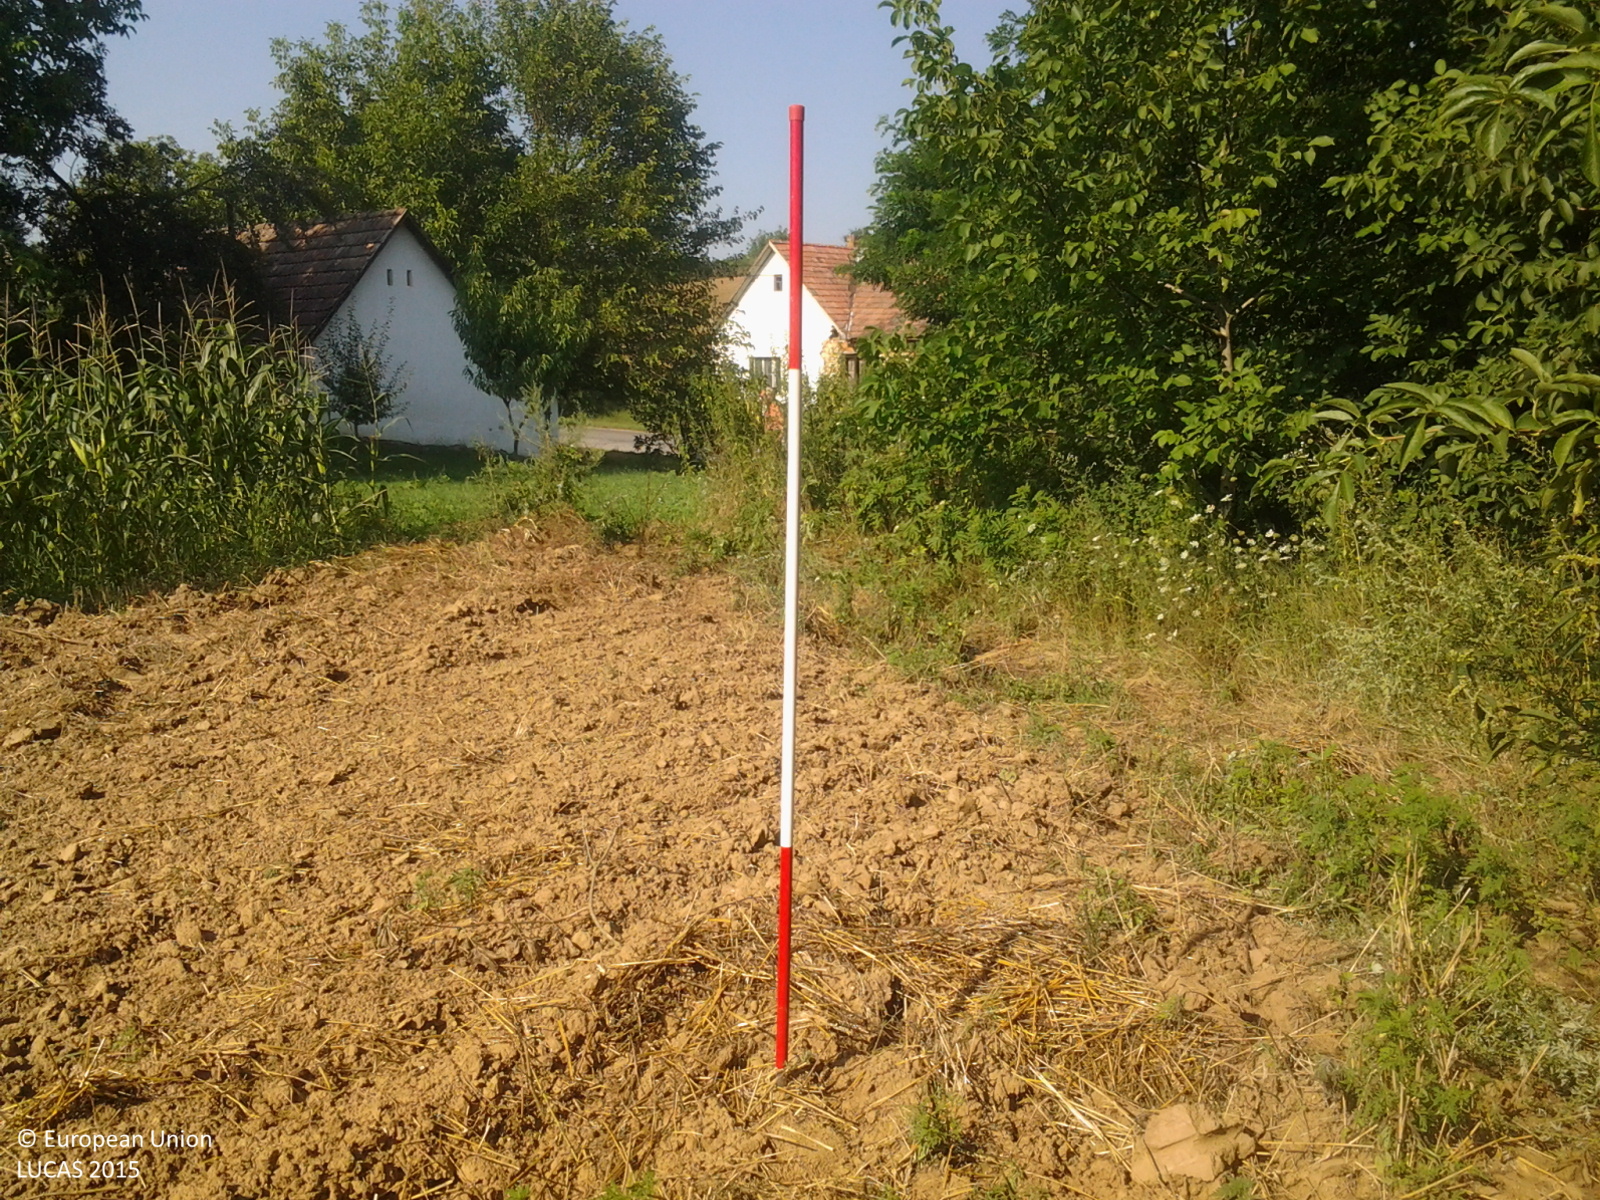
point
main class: Cropland
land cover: Common wheat
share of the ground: < 10 %
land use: Agriculture (excluding fallow land and kitchen gardens)
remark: Harvested field
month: August
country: HU
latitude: 46.5180
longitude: 18.2860
